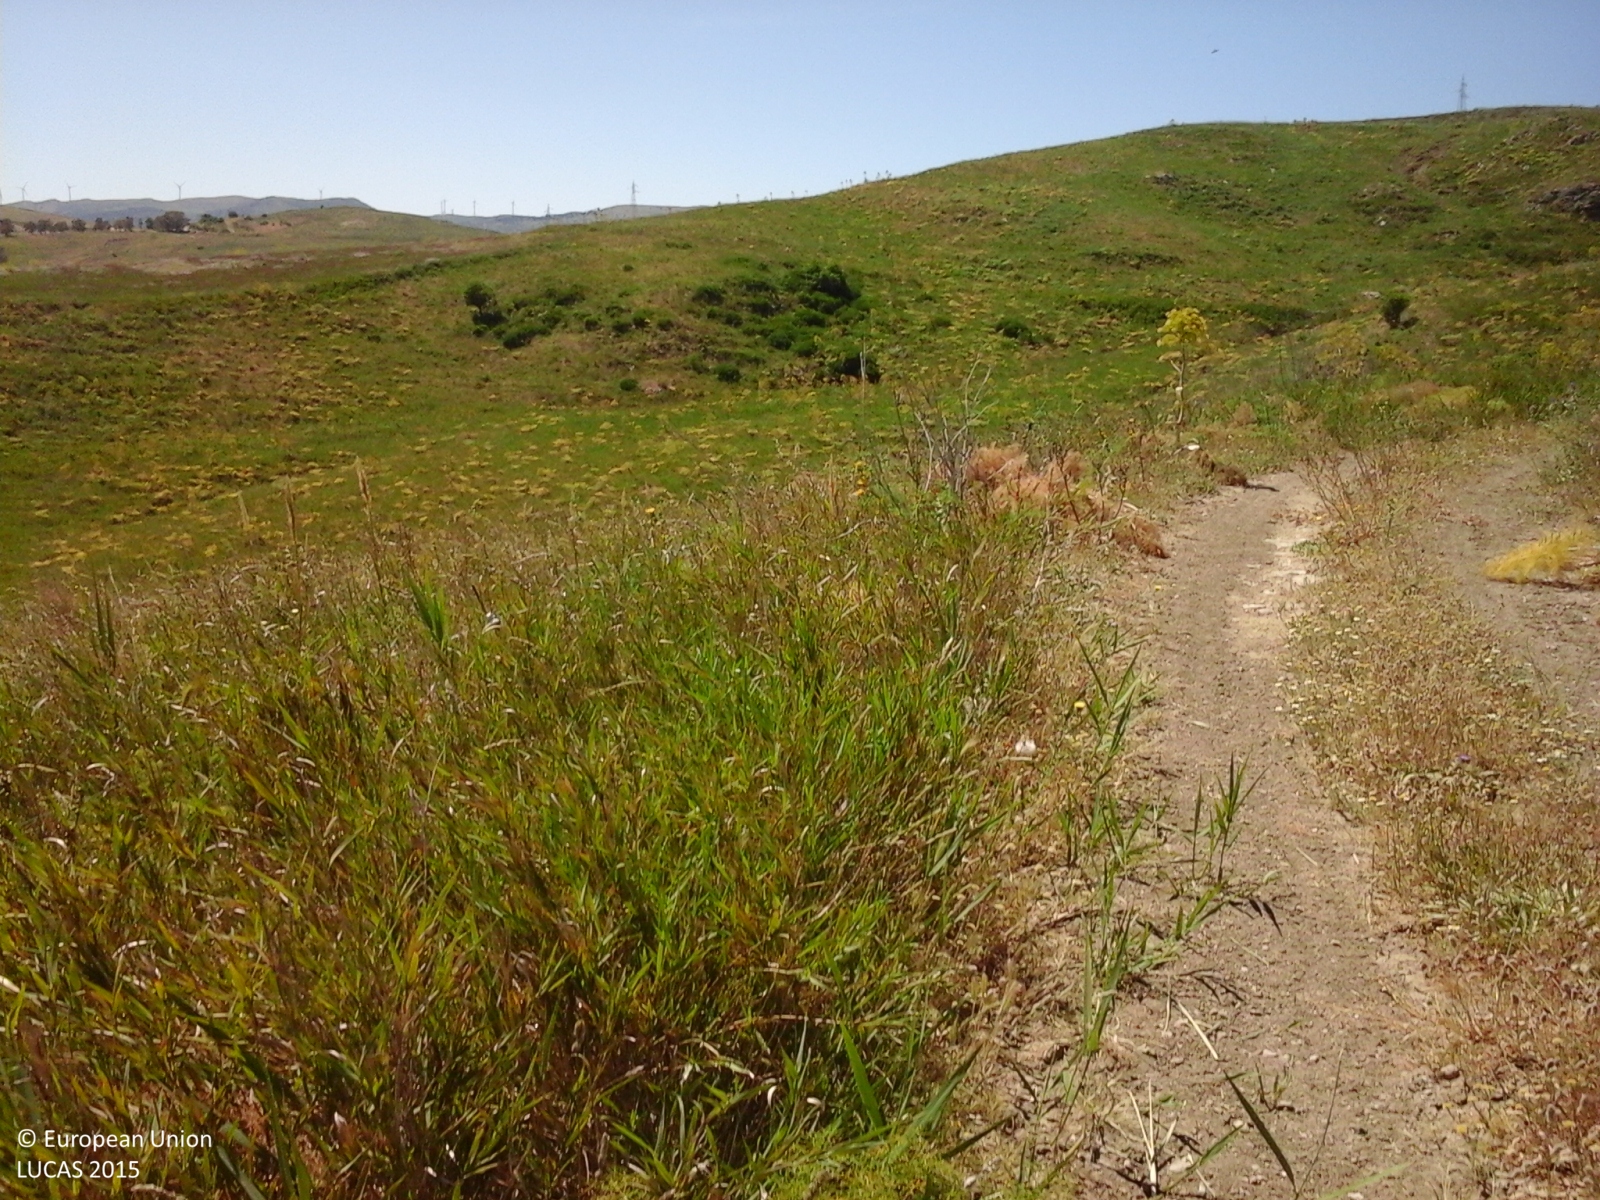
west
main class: Grassland
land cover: Grassland without tree/shrub cover
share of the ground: > 75 %
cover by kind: herbaceous plants 100 %
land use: Agriculture (excluding fallow land and kitchen gardens)
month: May
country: IT
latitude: 37.5911
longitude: 13.9910
